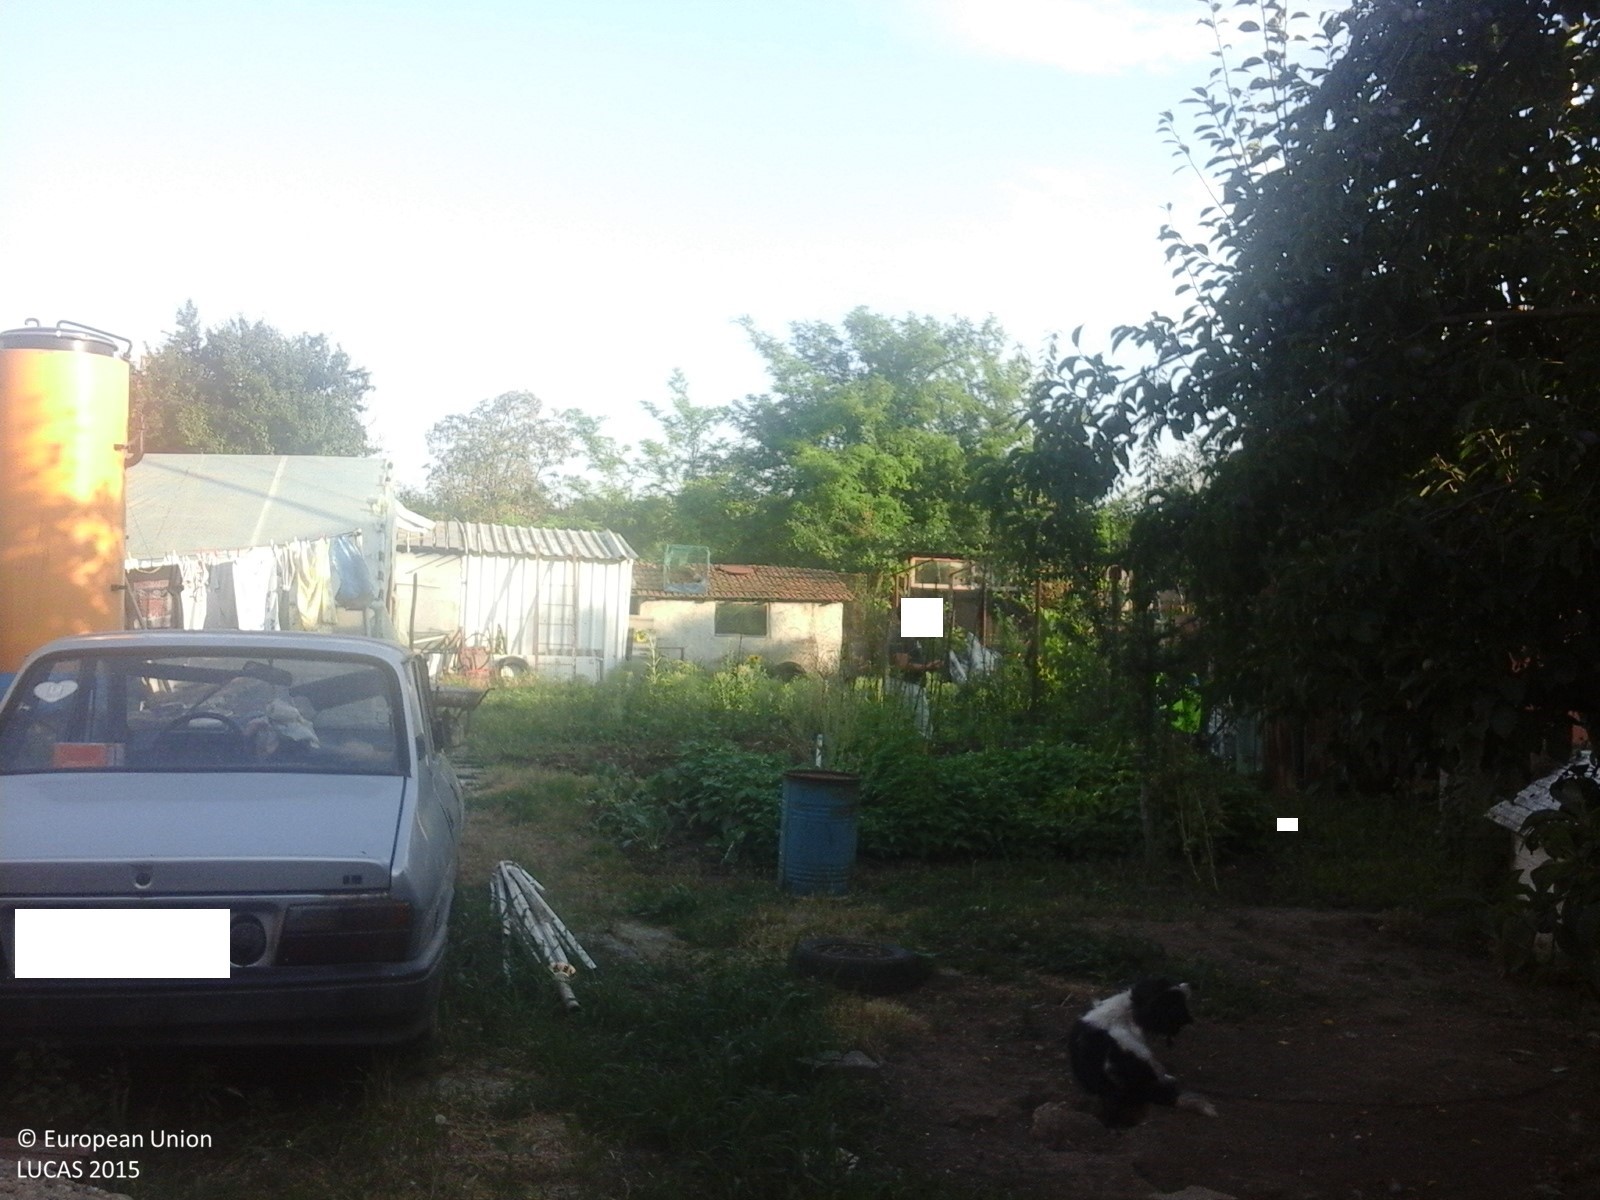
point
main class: Cropland
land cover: Other fresh vegetables
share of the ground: > 75 %
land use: Kitchen garden
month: July
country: RO
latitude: 43.9541
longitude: 25.9344
